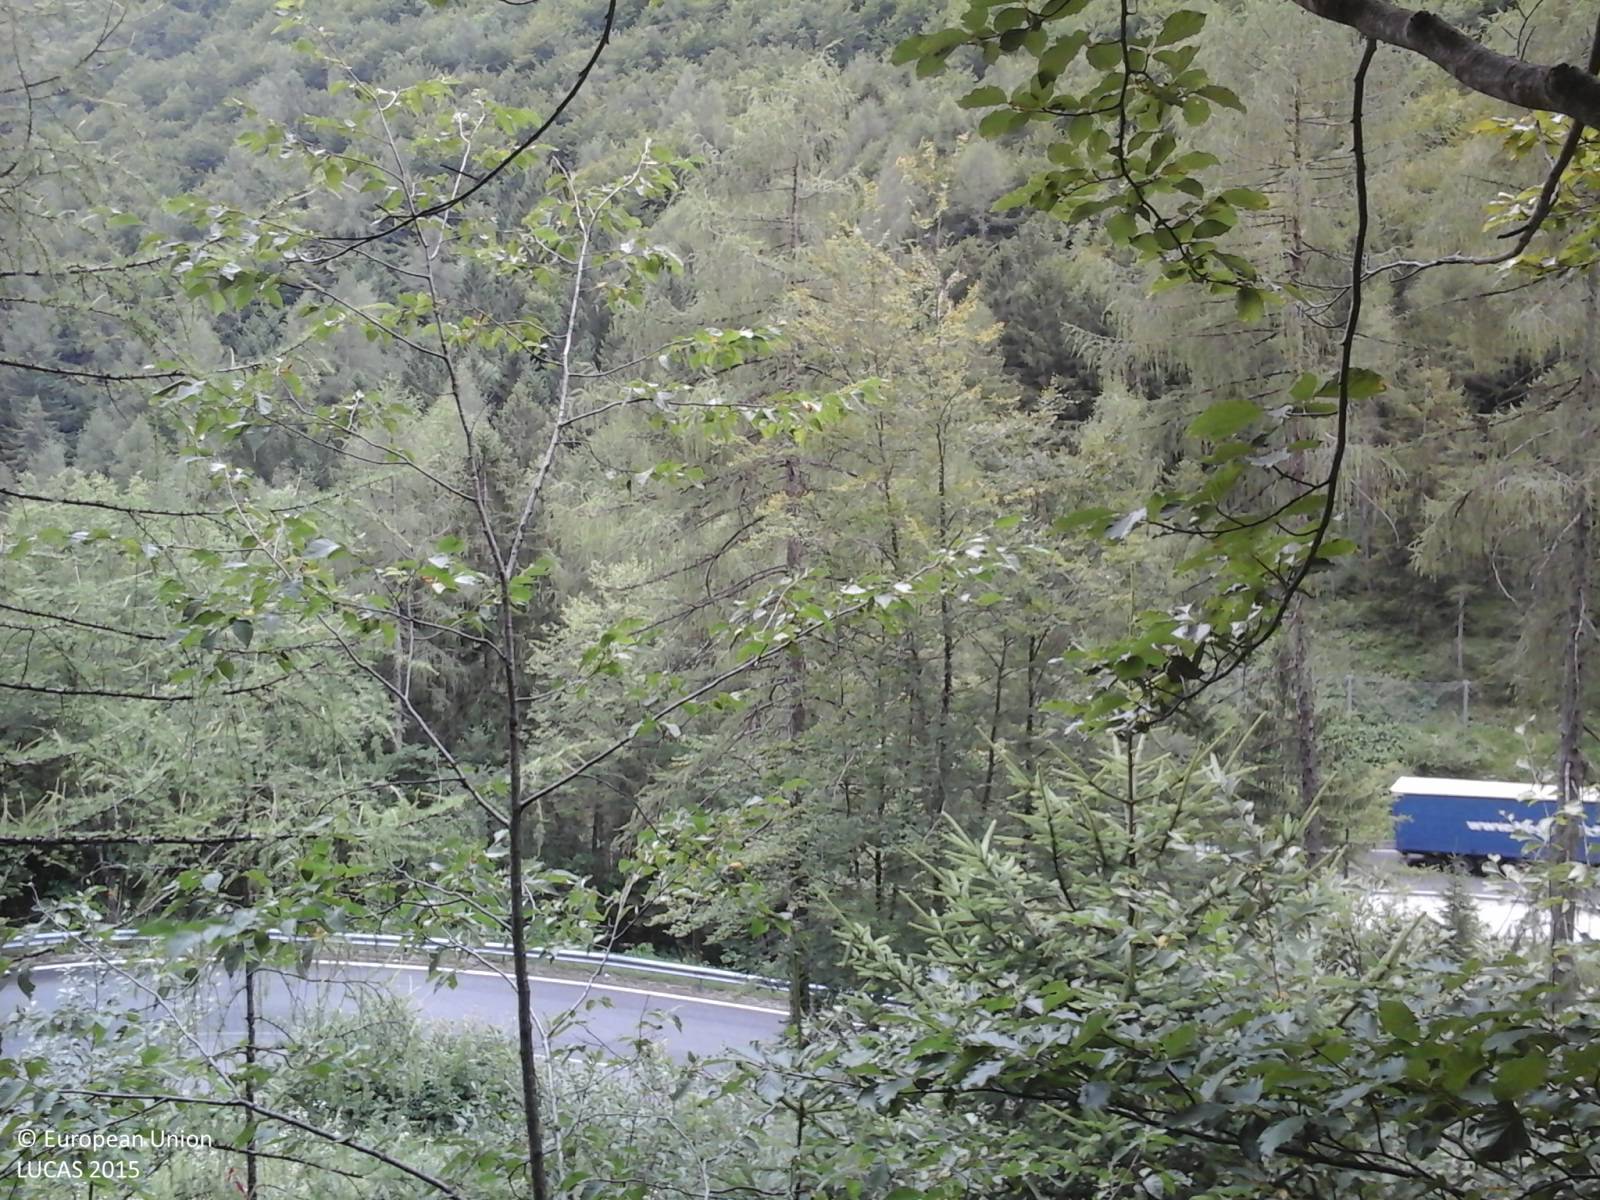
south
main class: Woodland
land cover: Broadleaved woodland
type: mountainous beech forest
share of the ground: > 75 %
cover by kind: broadleaved forest trees 75 %, coniferous forest trees 25 %
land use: Forestry
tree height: > 5 m
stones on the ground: > 50 %
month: July
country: IT
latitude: 46.2877
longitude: 12.4244
